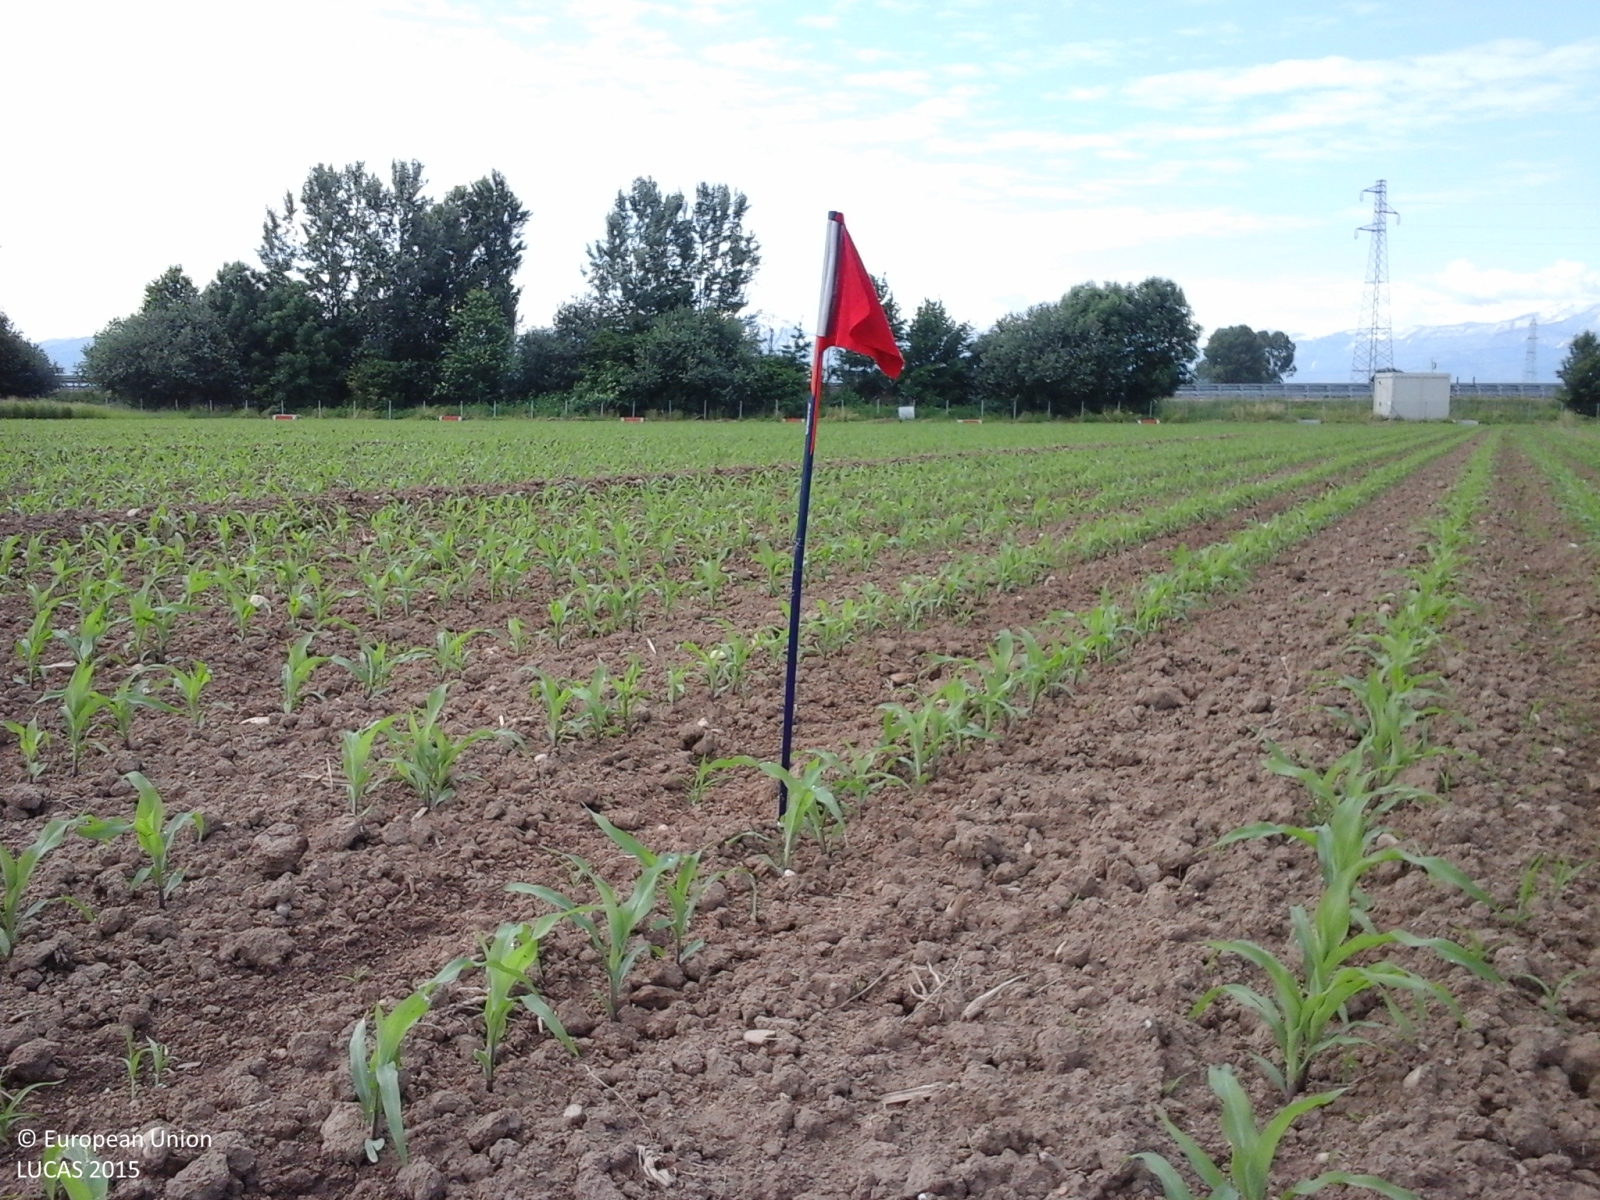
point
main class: Cropland
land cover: Maize
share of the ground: 10 - 25 %
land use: Agriculture (excluding fallow land and kitchen gardens)
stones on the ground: 10 - 25 %
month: May
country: IT
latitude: 44.4706
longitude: 7.7545
